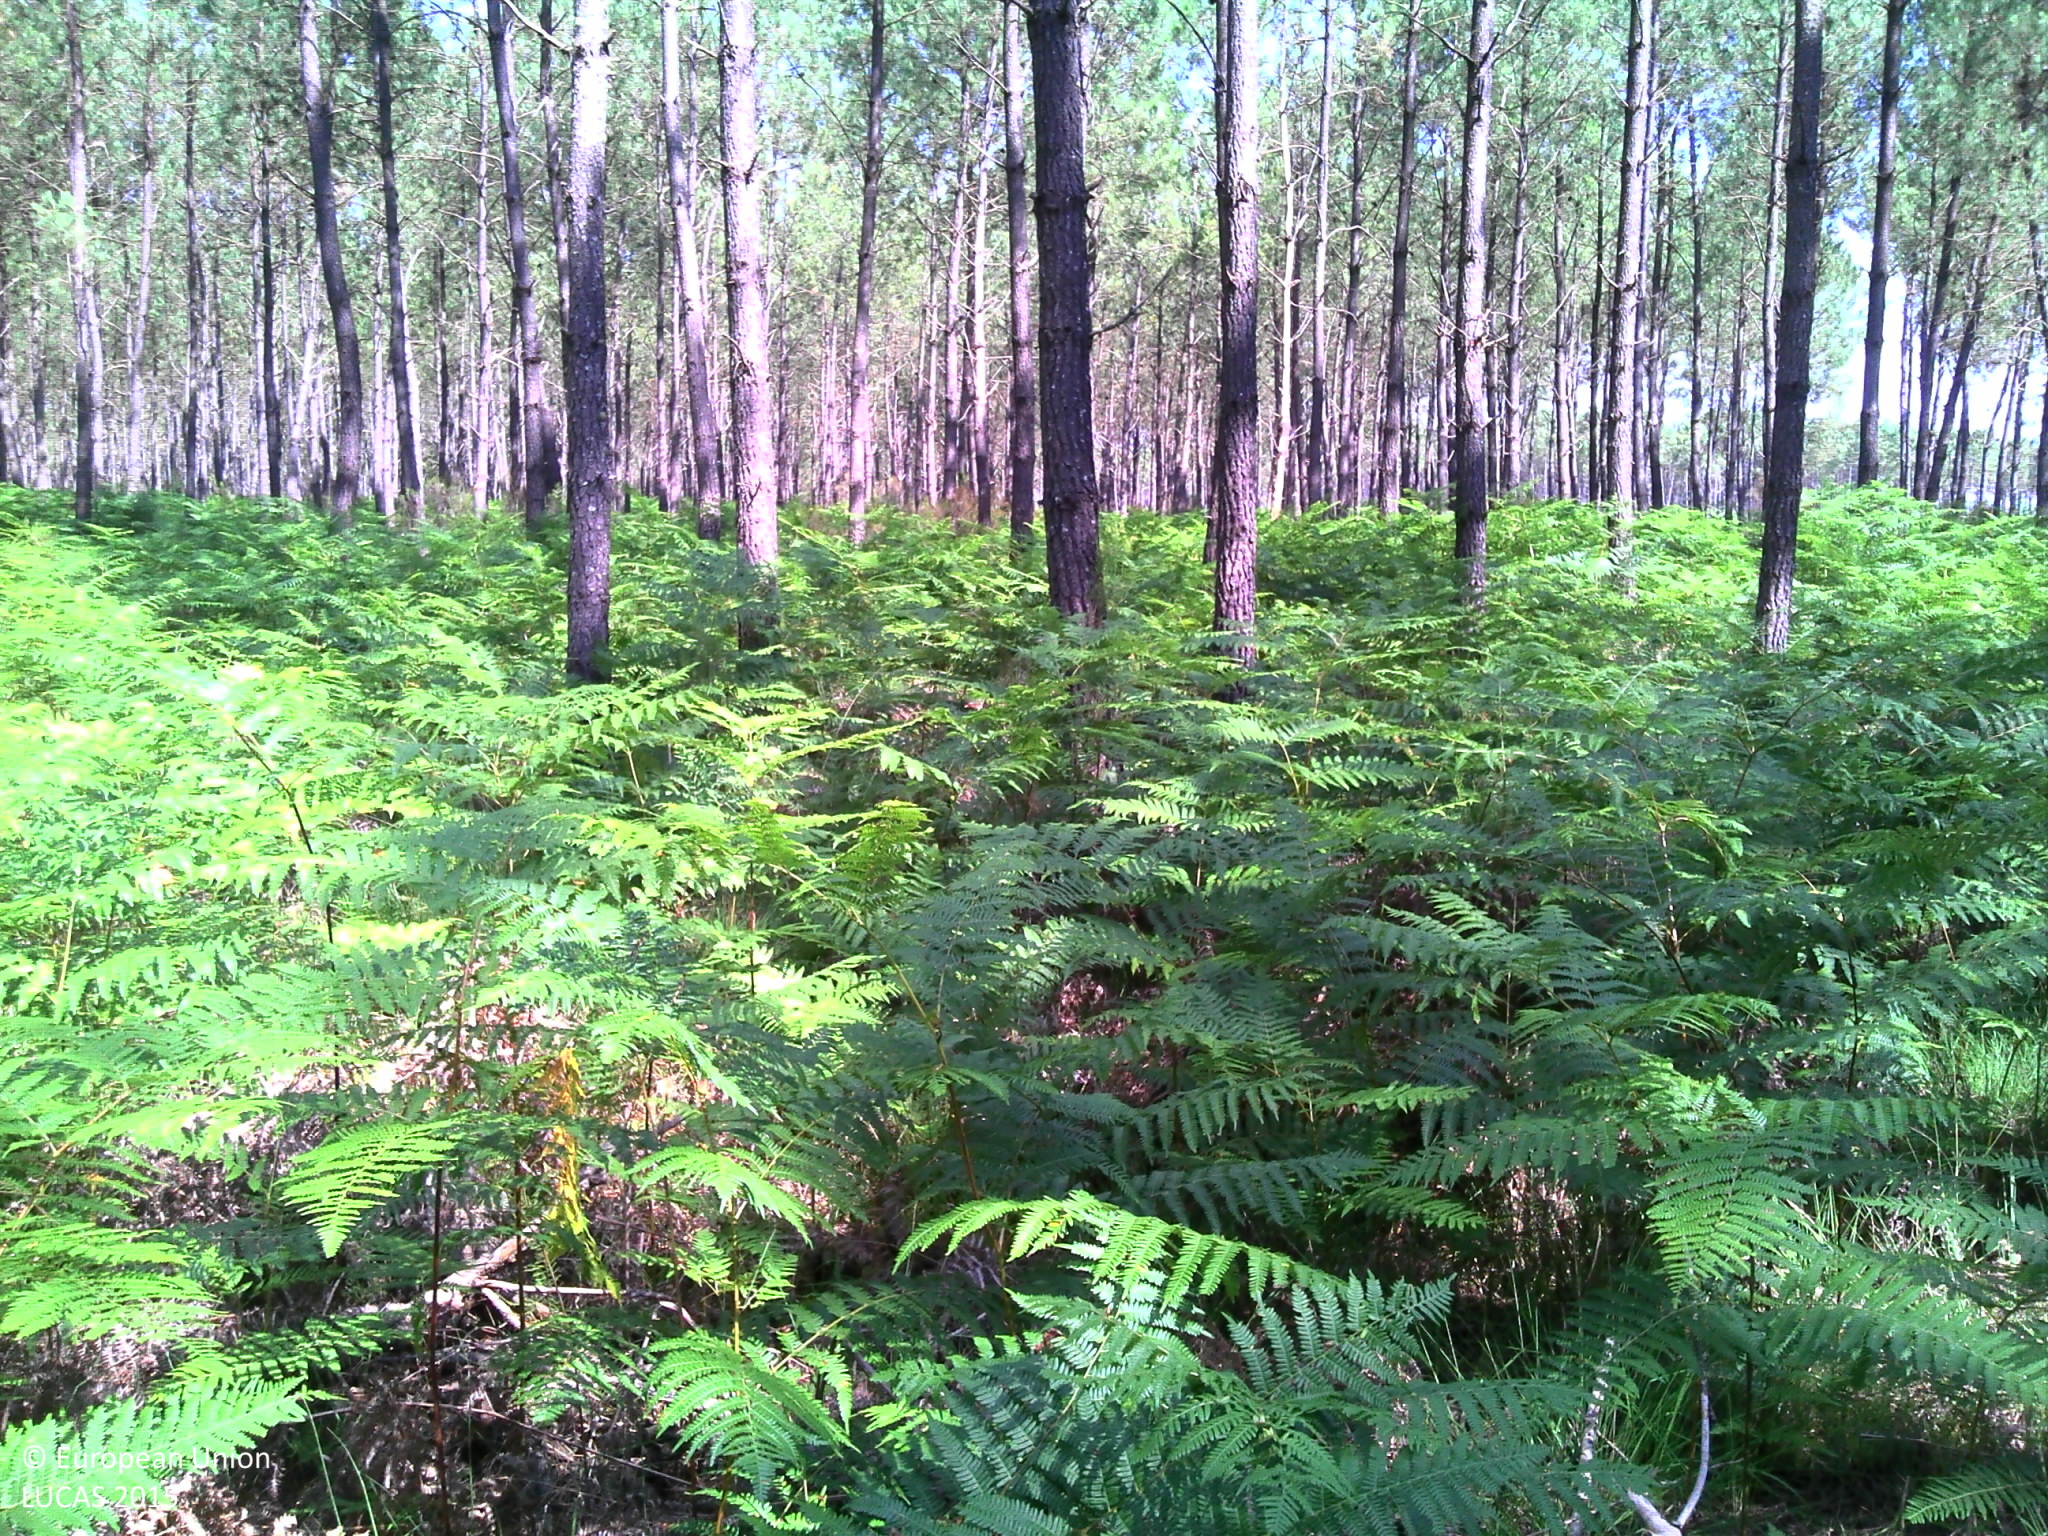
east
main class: Woodland
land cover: Pine dominated coniferous woodland
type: coniferous forest of the mediterranean region
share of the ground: > 75 %
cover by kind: coniferous forest trees 70 %, herbaceous plants 30 %
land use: Forestry
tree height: > 5 m
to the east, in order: Pine dominated coniferous woodland; Tracks; Grass margins; Ditches and canals; Pine dominated coniferous woodland
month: July
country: FR
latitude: 44.2911
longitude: -0.4788
